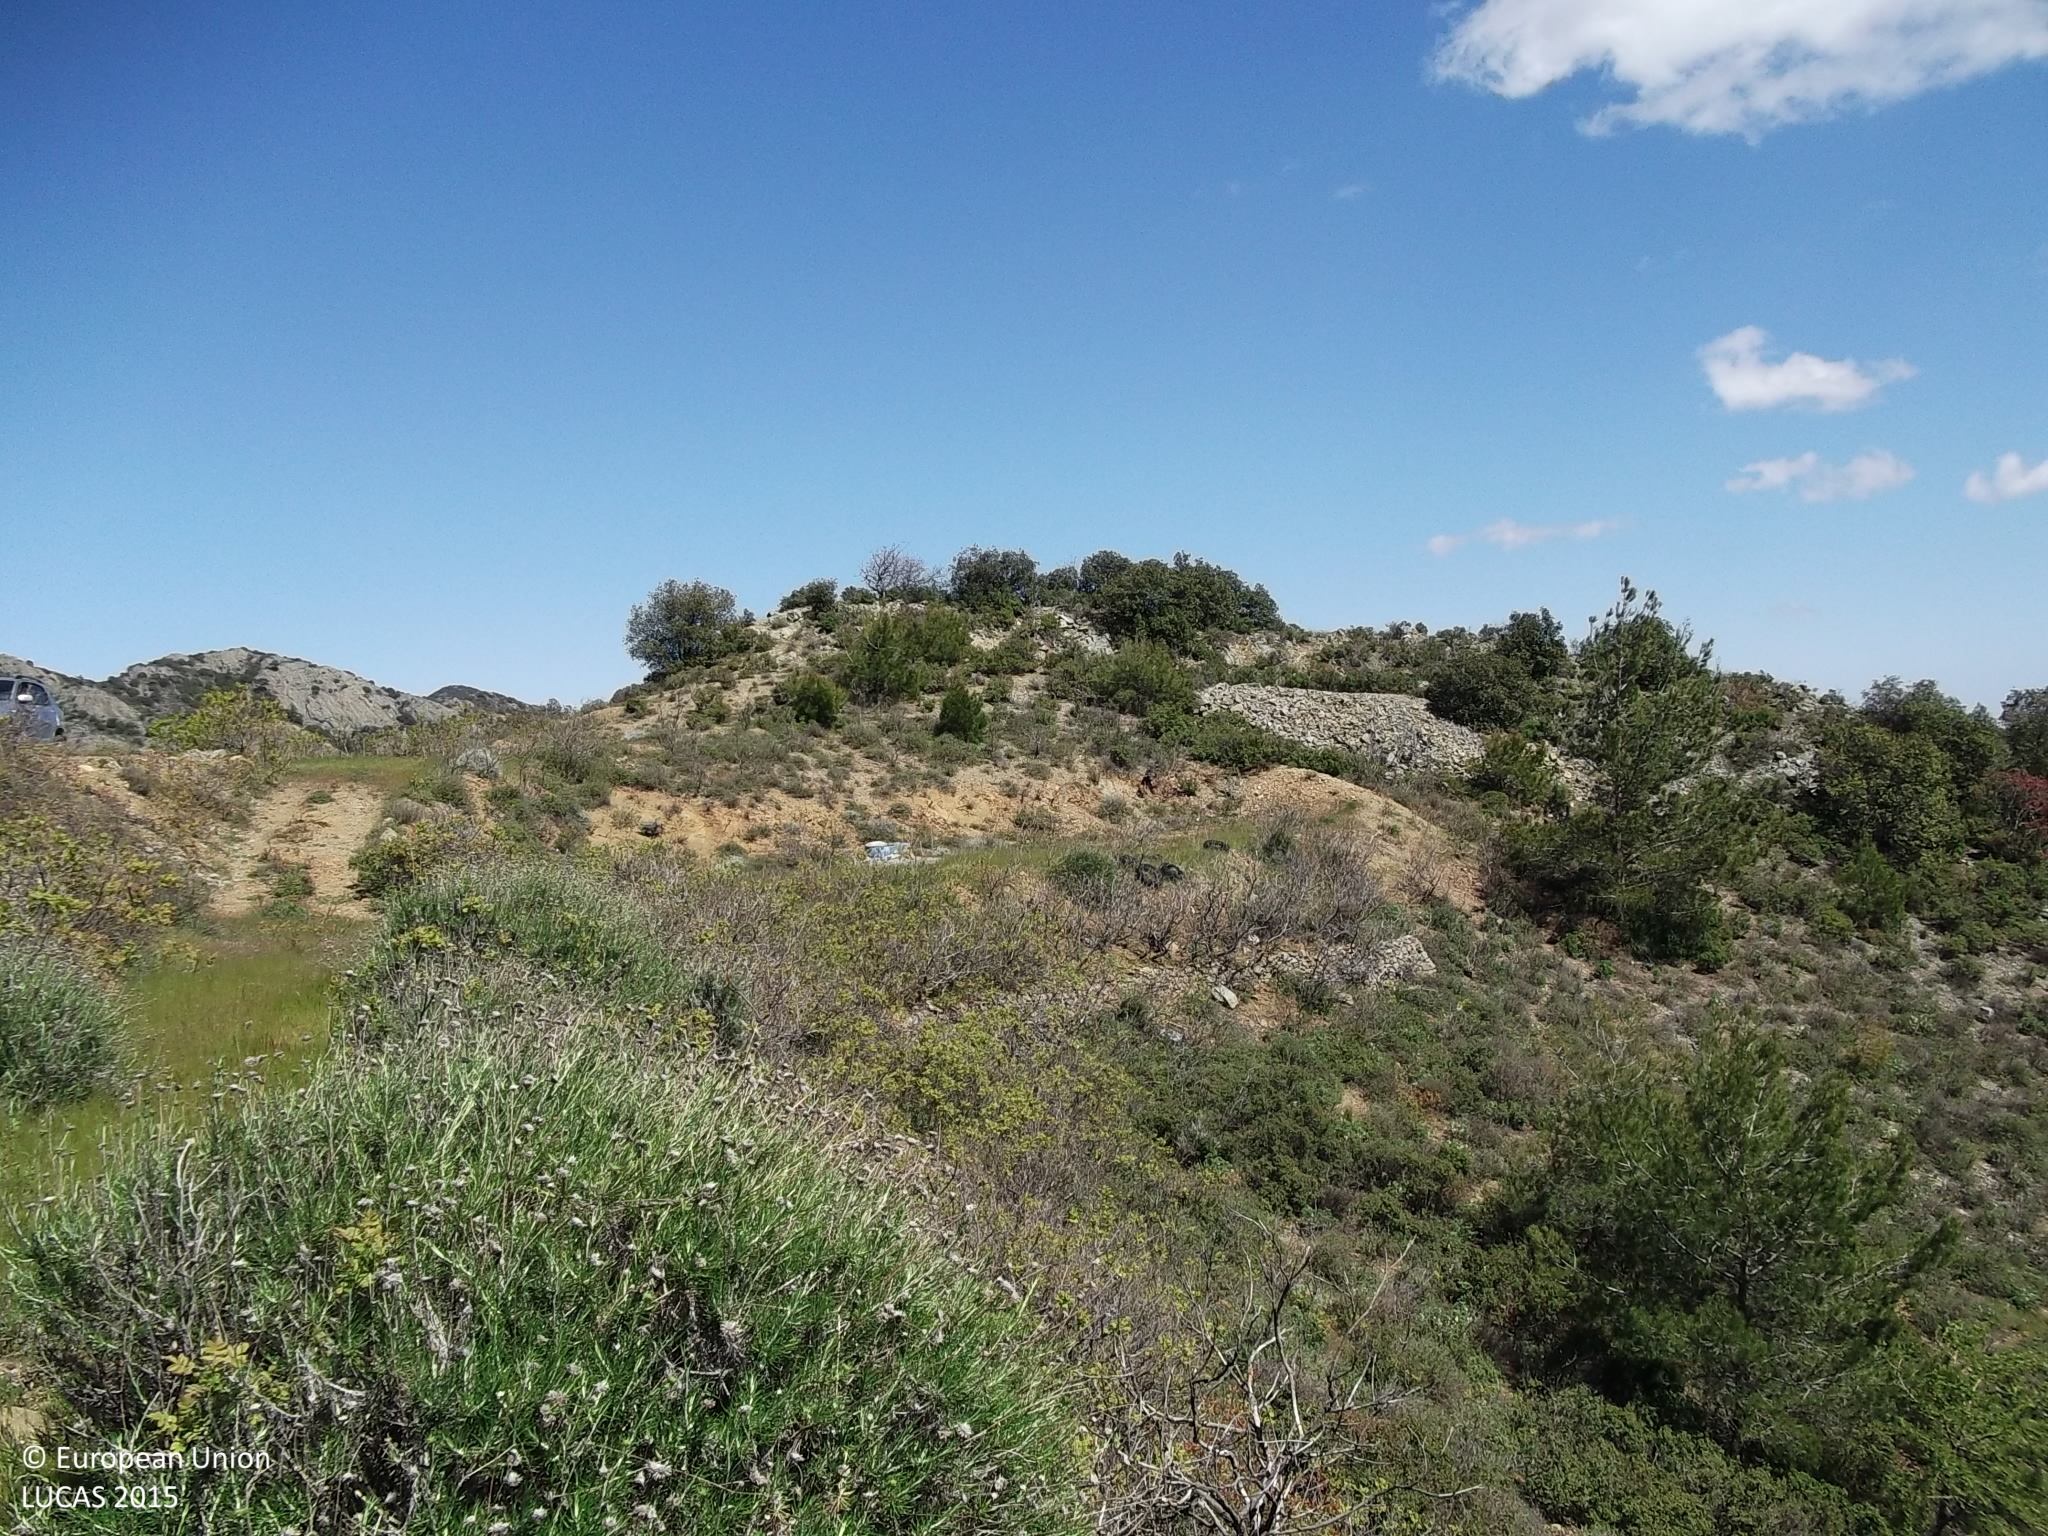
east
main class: Woodland
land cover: Pine dominated coniferous woodland
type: coniferous forest of the mediterranean region
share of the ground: 10 - 25 %
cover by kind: shrubs 65 %, coniferous forest trees 20 %, consolidated bare surface 10 %, unconsolidated bare surface 5 %
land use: Forestry
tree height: > 5 m
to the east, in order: Pine dominated coniferous woodland; Rocks and stones; Shrubland without tree cover
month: April
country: CY
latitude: 34.9005
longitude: 33.1695
